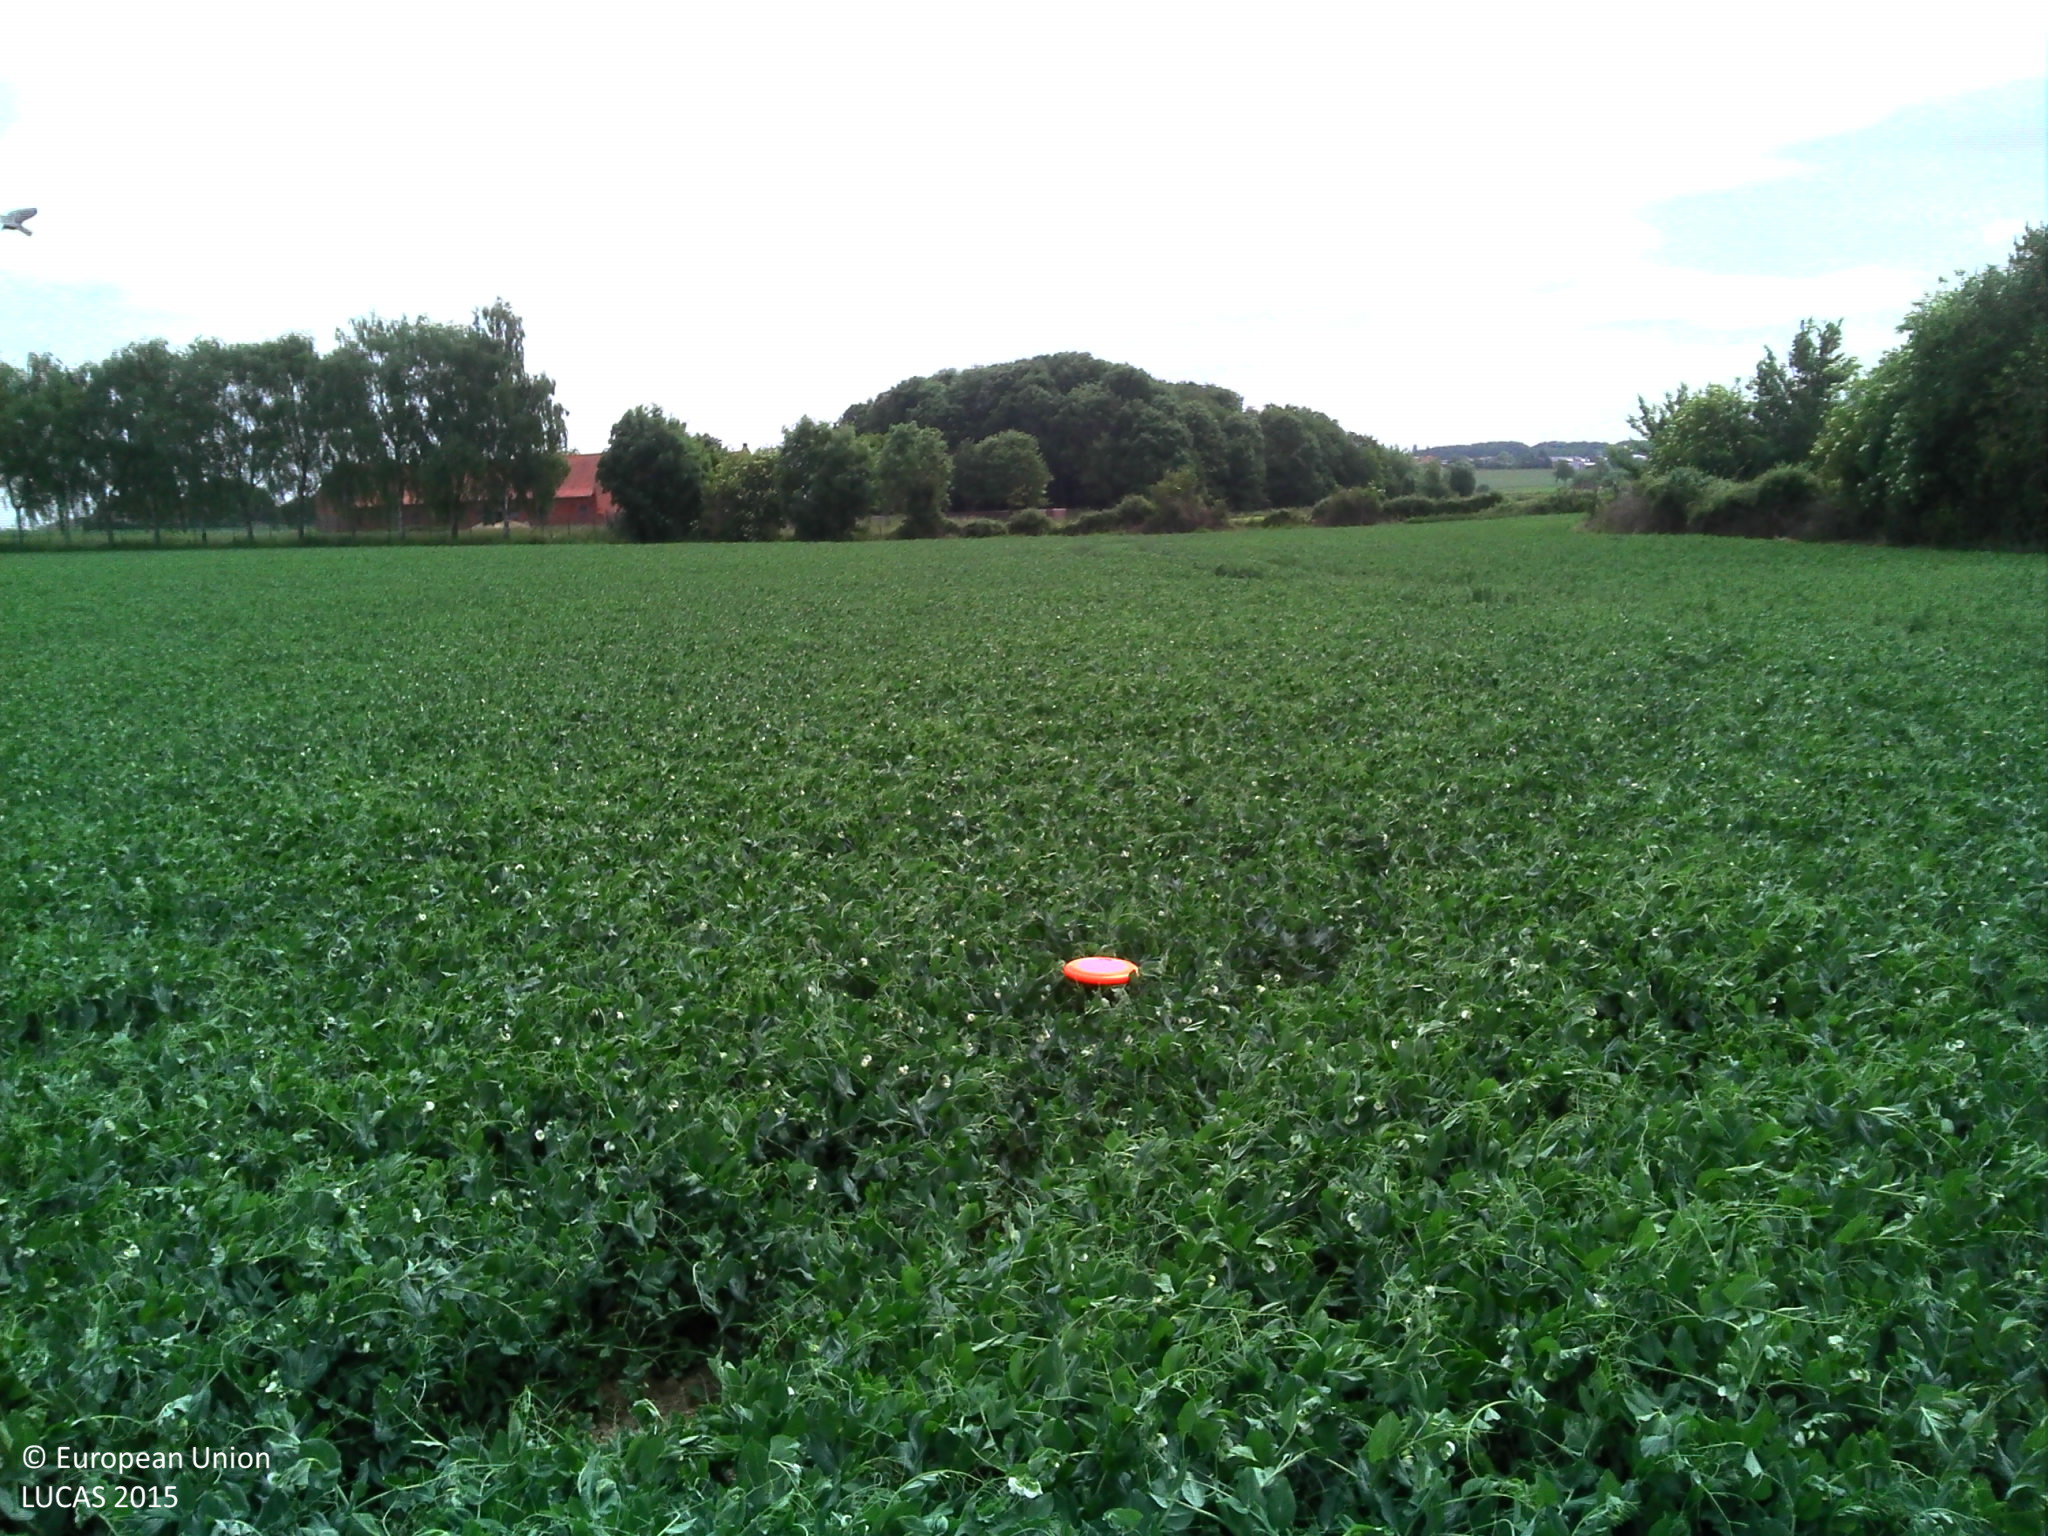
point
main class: Cropland
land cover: Dry pulses
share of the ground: > 75 %
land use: Agriculture (excluding fallow land and kitchen gardens)
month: June
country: BE
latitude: 50.8296
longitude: 2.9048
